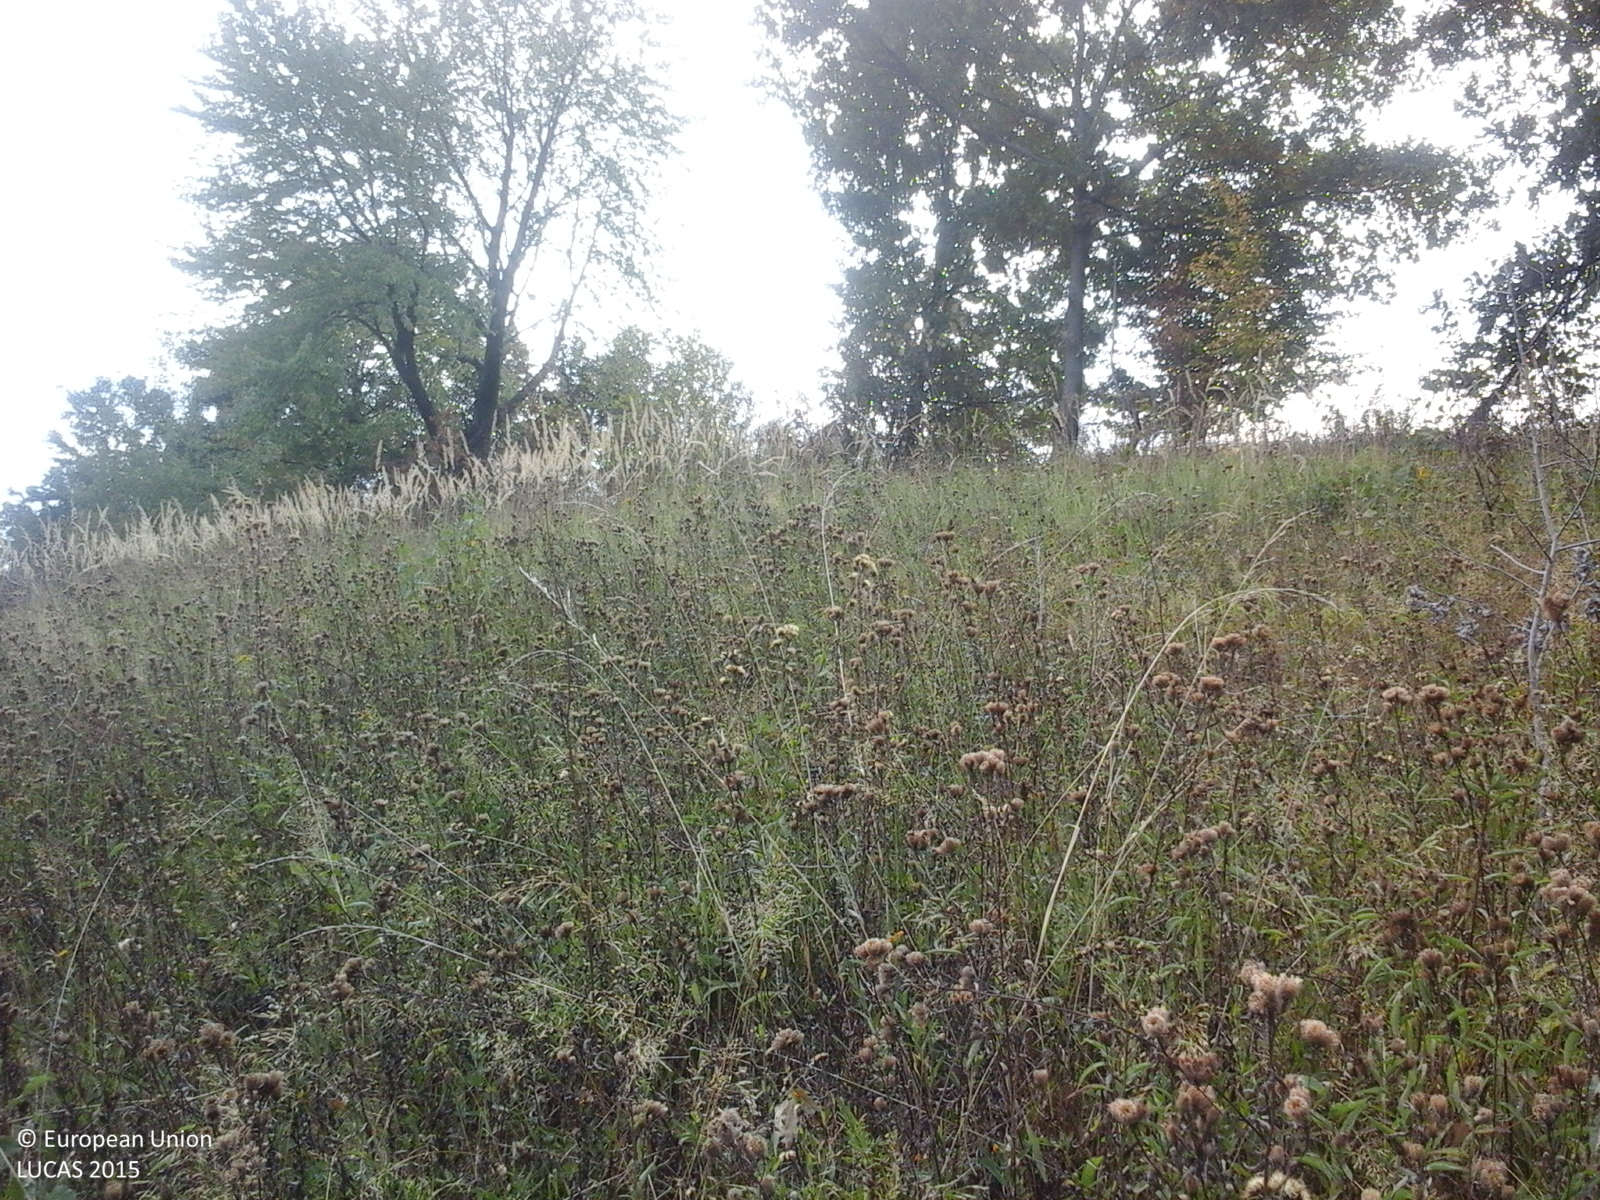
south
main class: Grassland
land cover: Grassland with sparse tree/shrub cover
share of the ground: > 75 %
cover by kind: herbaceous plants 85 %, shrubs 10 %, broadleaved forest trees 5 %
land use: Fallow land
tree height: < 5 m
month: September
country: RO
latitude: 45.3342
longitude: 22.2524
